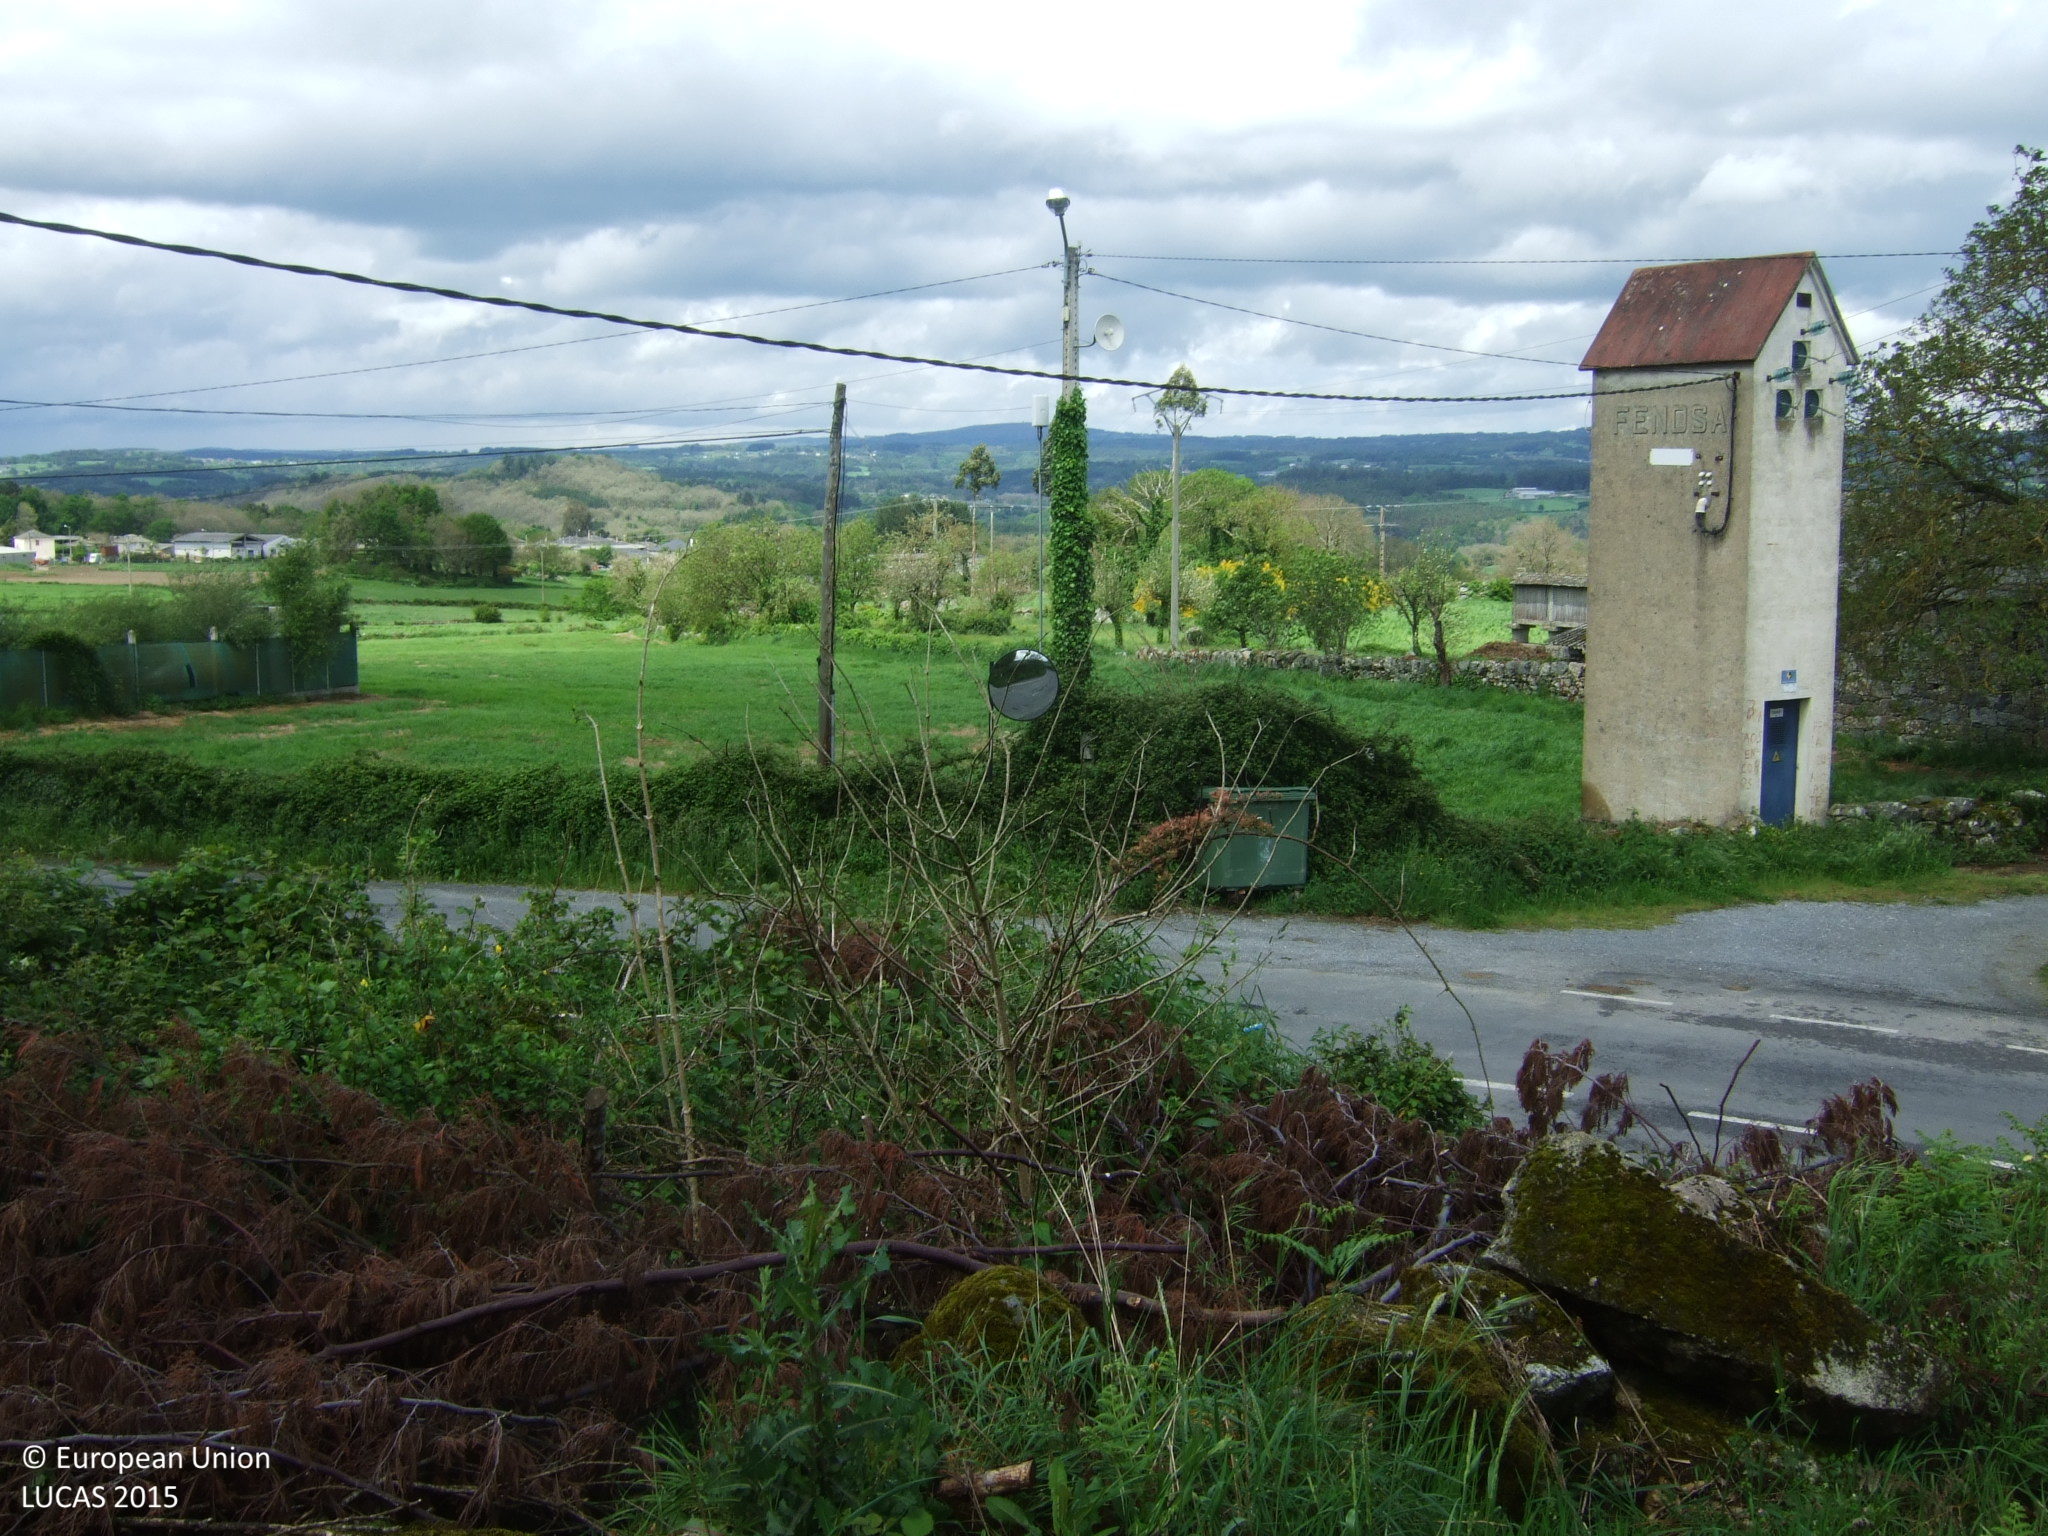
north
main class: Grassland
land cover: Grassland without tree/shrub cover
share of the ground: > 75 %
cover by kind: herbaceous plants 100 %
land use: Residential
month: May
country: ES
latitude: 42.8214
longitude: -7.5534
